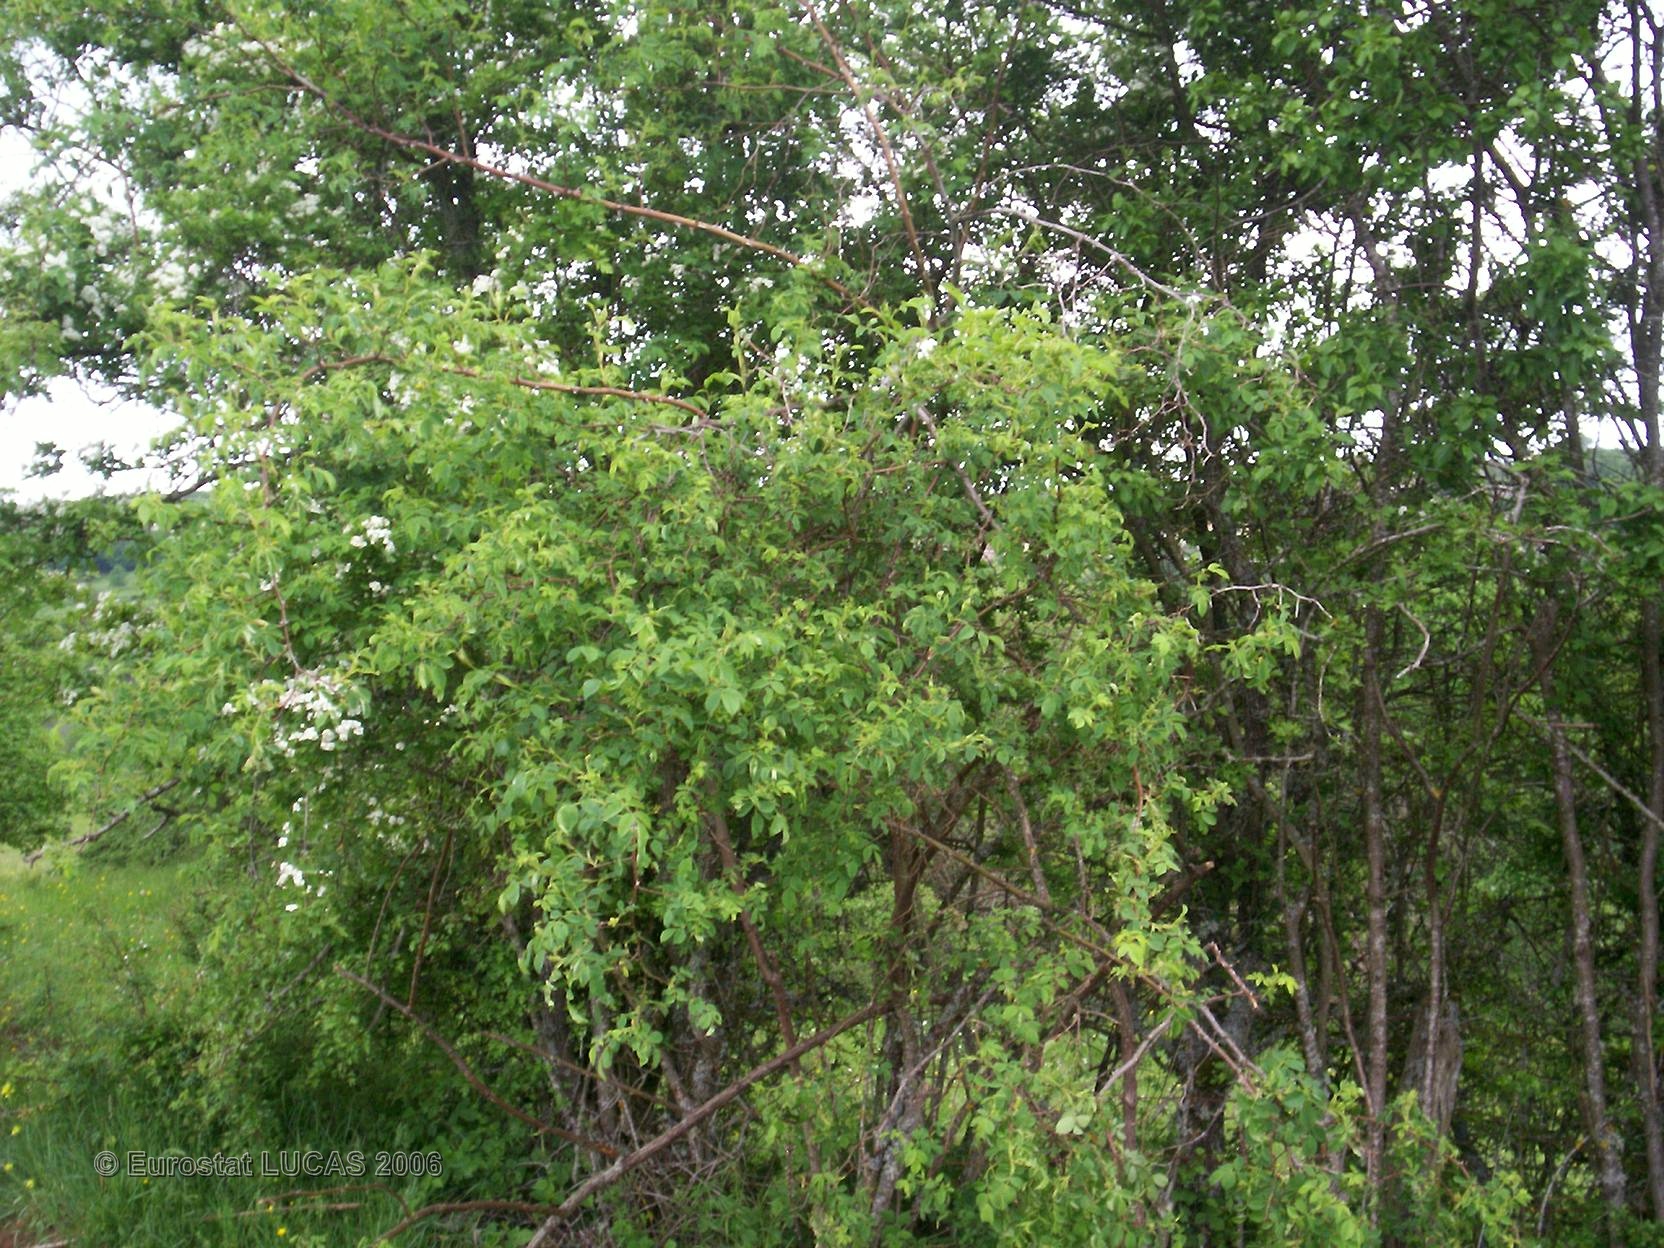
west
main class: Grassland
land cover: Grassland without tree/shrub cover
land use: Agriculture (excluding fallow land and kitchen gardens)
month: May
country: FR
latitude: 47.1741
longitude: 4.6565
